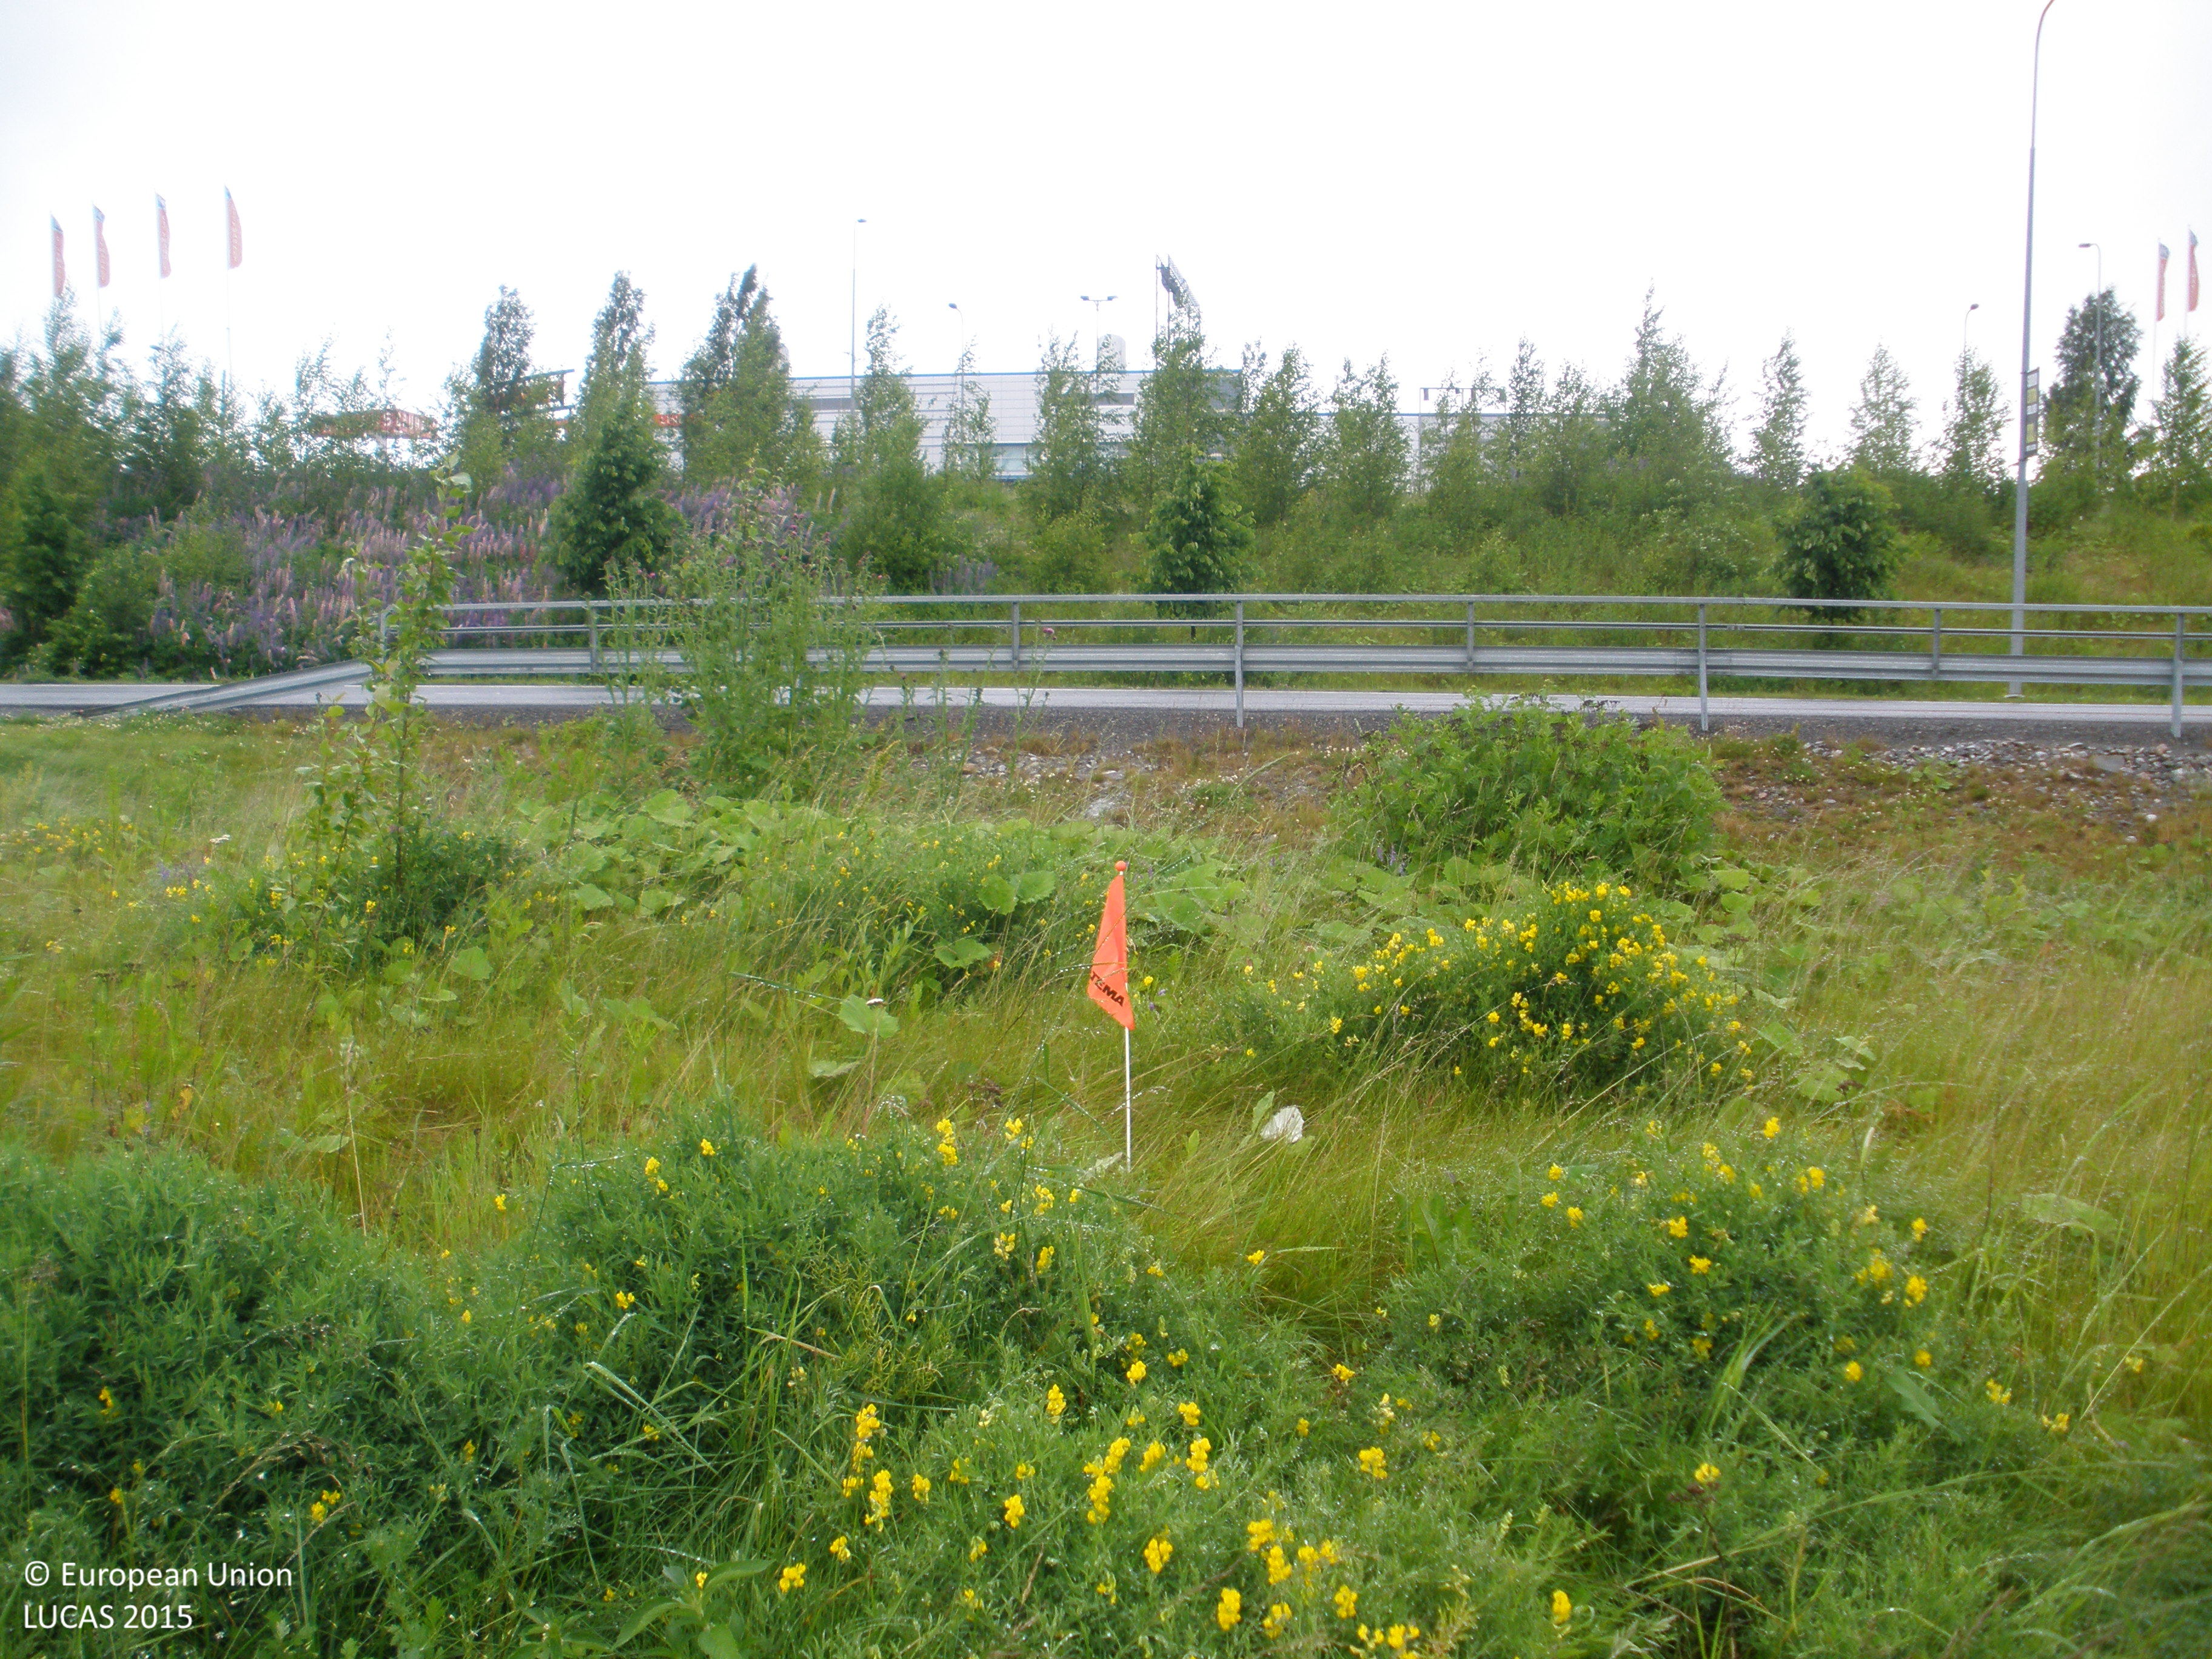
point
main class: Grassland
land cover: Spontaneously vegetated surfaces
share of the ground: > 75 %
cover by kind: herbaceous plants 95 %, shrubs 5 %
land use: Road transport
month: July
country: FI
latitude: 61.4660
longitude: 23.7268
